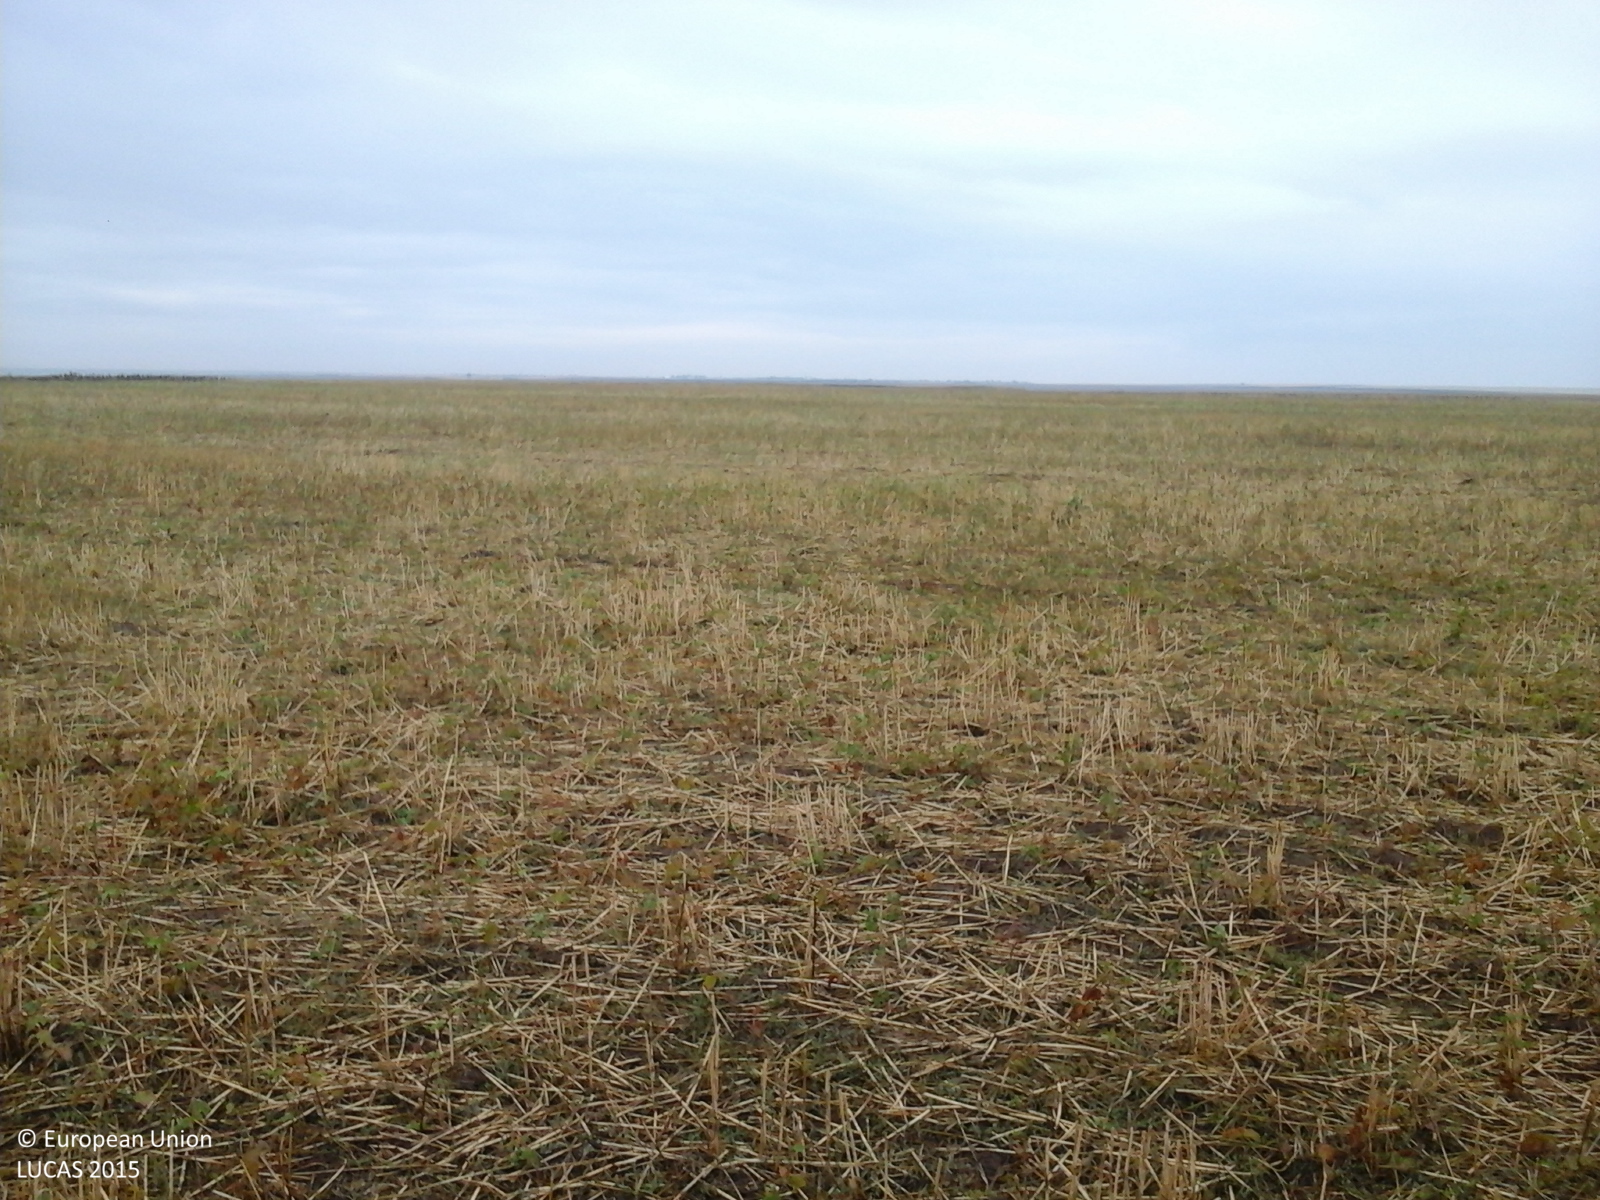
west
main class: Cropland
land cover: Common wheat
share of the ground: > 75 %
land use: Agriculture (excluding fallow land and kitchen gardens)
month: August
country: RO
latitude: 46.0232
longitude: 21.4671
